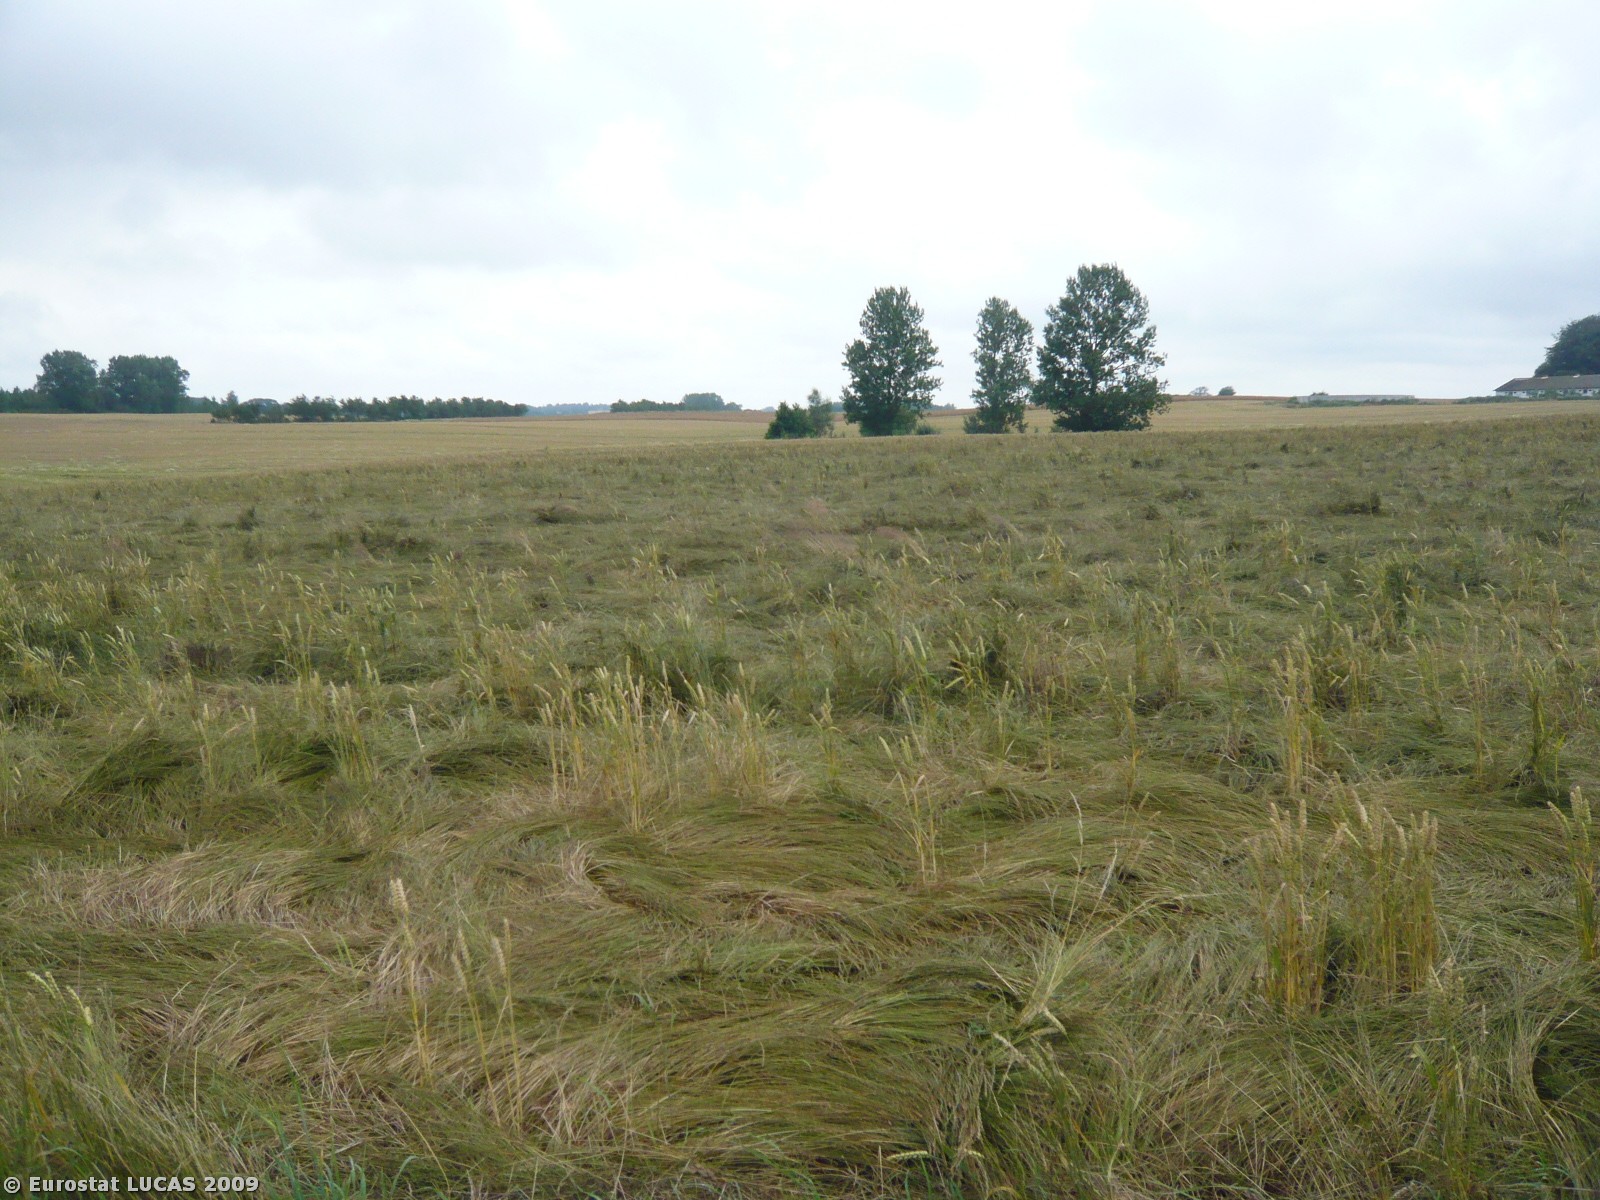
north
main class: Cropland
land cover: Rape and turnip rape
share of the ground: > 75 %
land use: Agriculture (excluding fallow land and kitchen gardens)
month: July
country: DK
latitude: 55.7423
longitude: 11.8938
